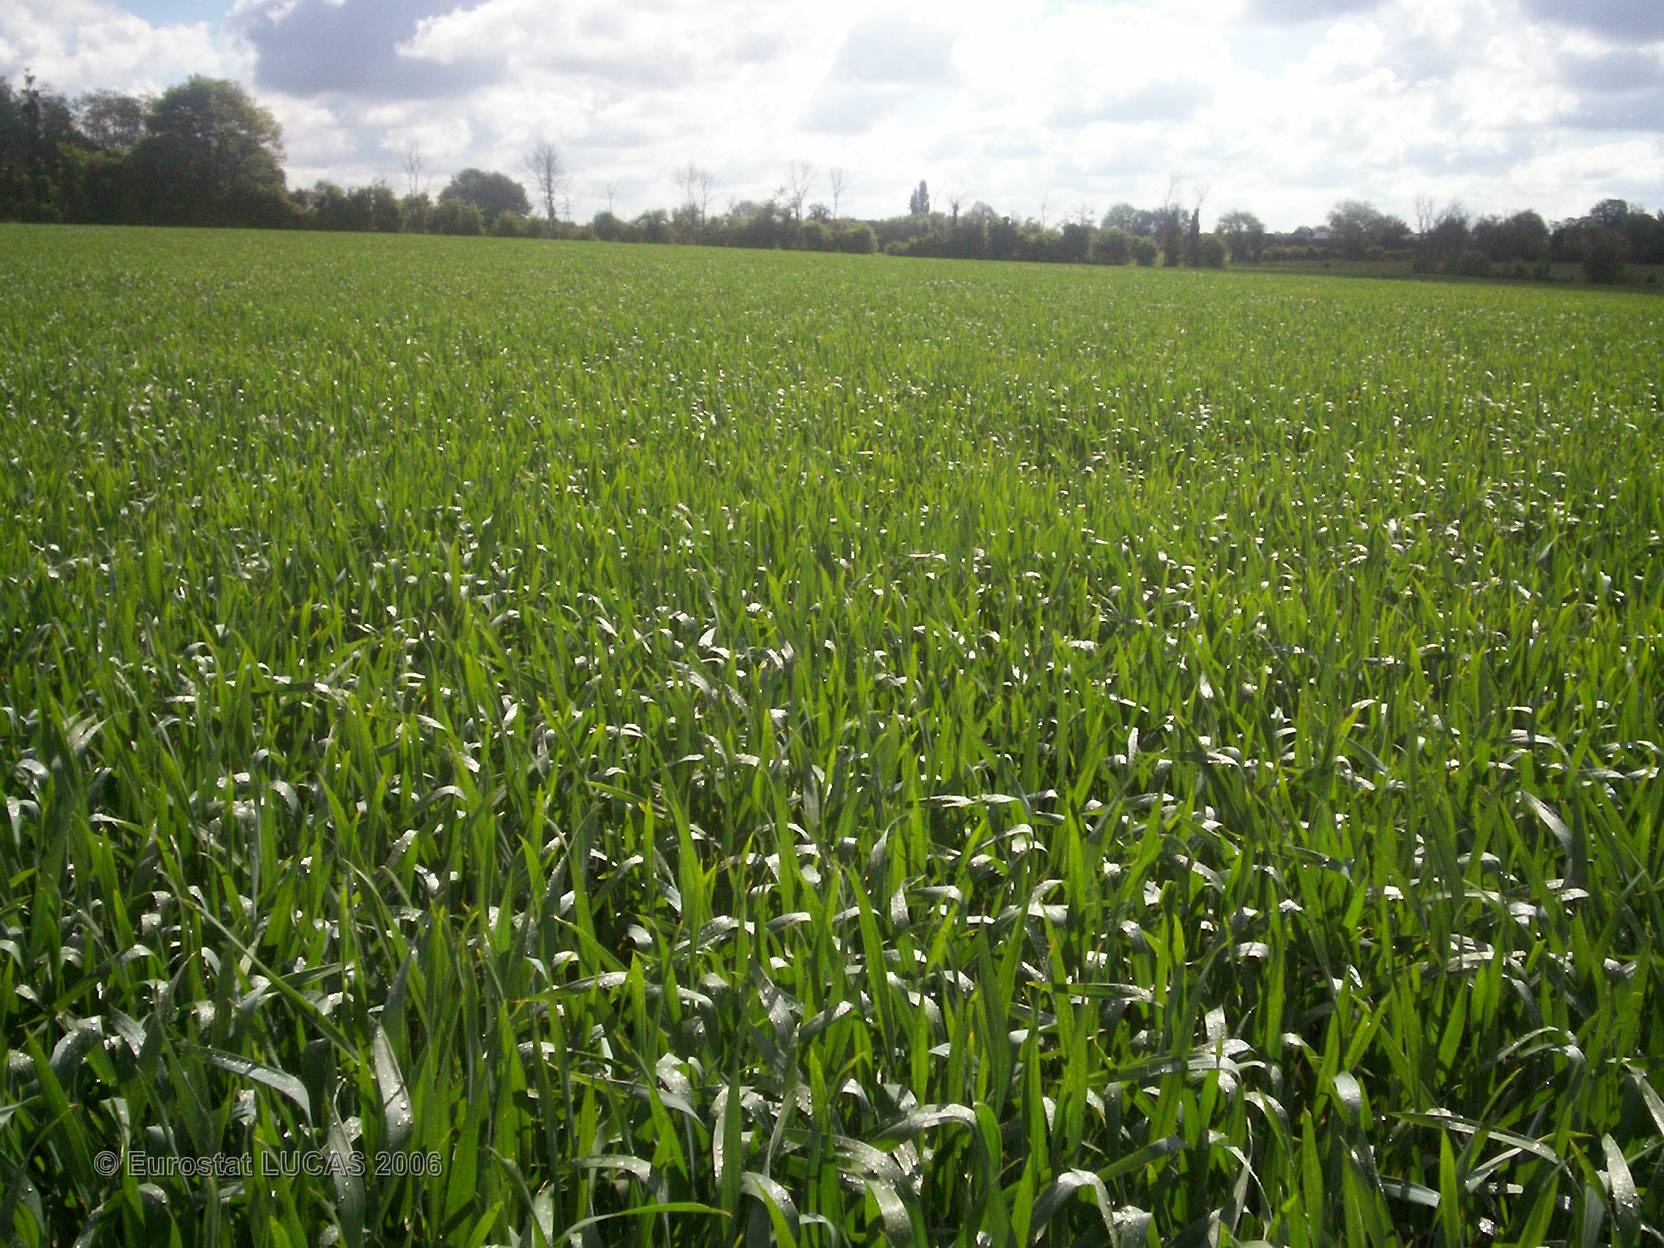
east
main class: Cropland
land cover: Common wheat
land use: Agriculture (excluding fallow land and kitchen gardens)
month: May
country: FR
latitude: 46.3455
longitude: 0.5110
